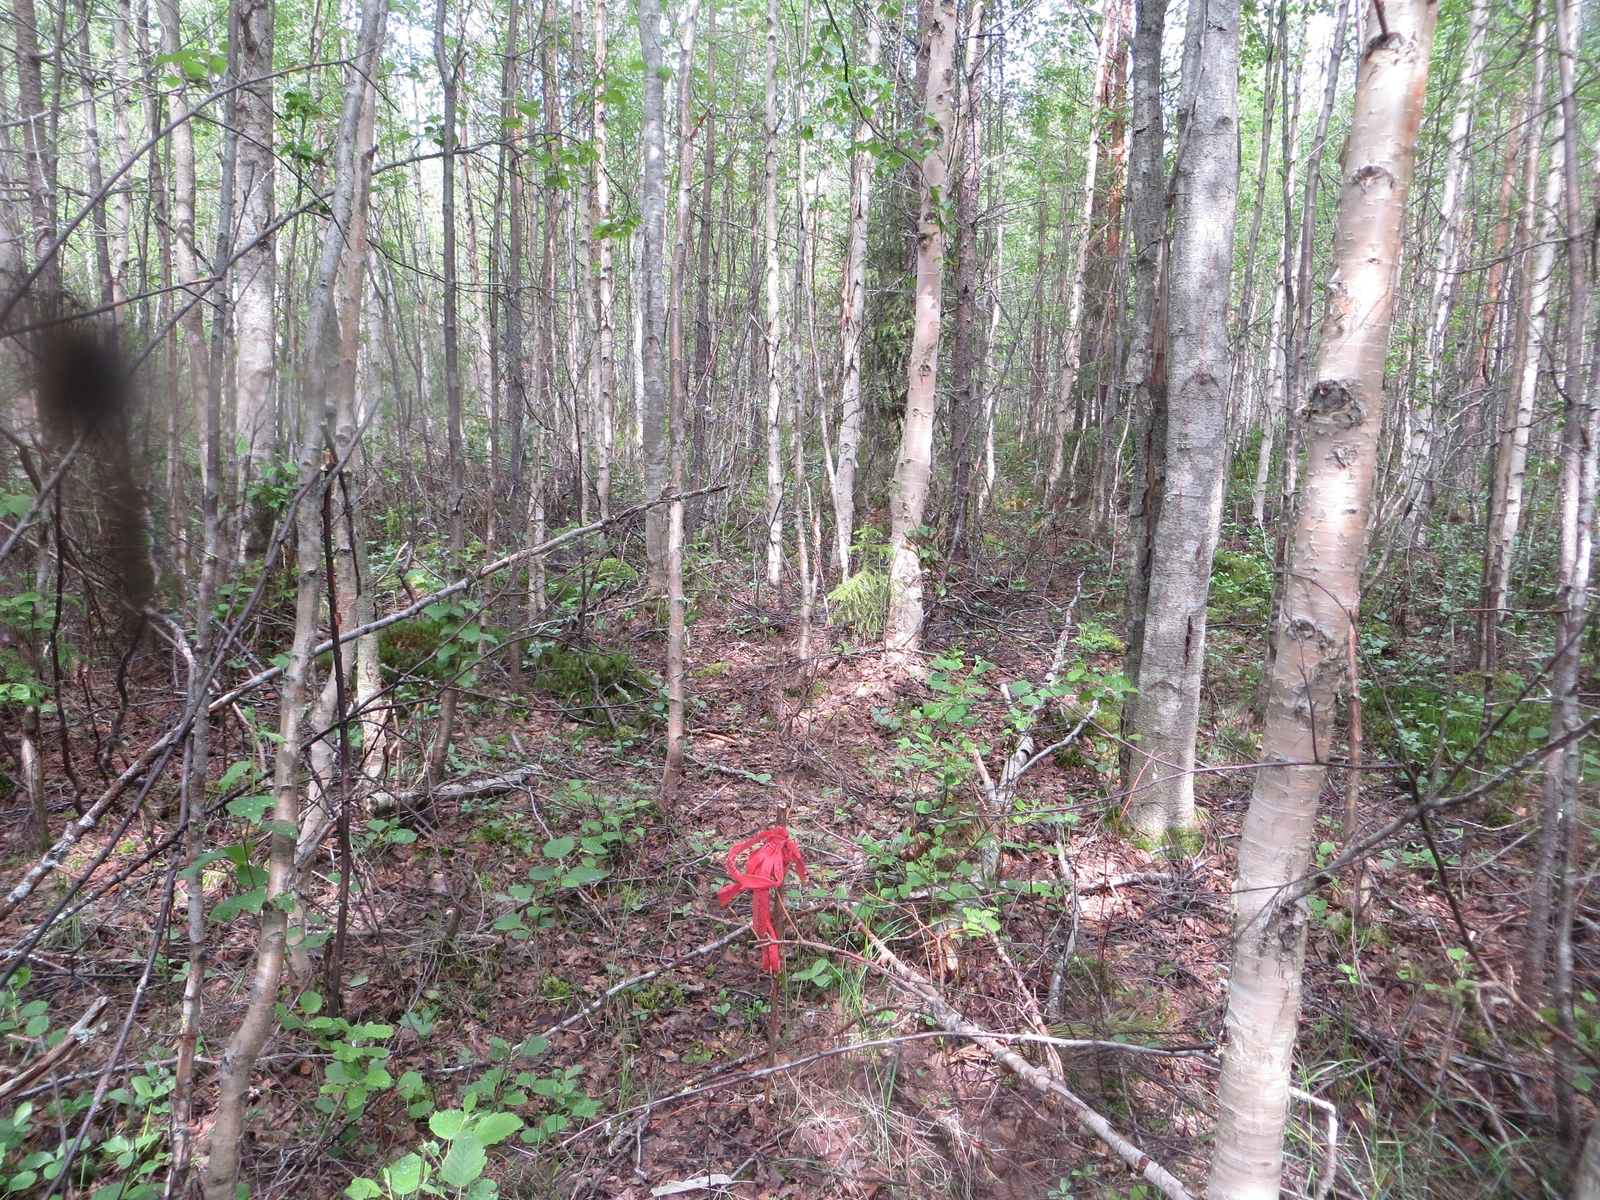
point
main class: Woodland
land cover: Pine dominated mixed woodland
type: boreal forest
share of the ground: > 75 %
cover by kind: broadleaved forest trees 50 %, coniferous forest trees 35 %, shrubs 15 %
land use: Forestry
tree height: > 5 m
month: July
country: FI
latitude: 65.4283
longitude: 25.8407
